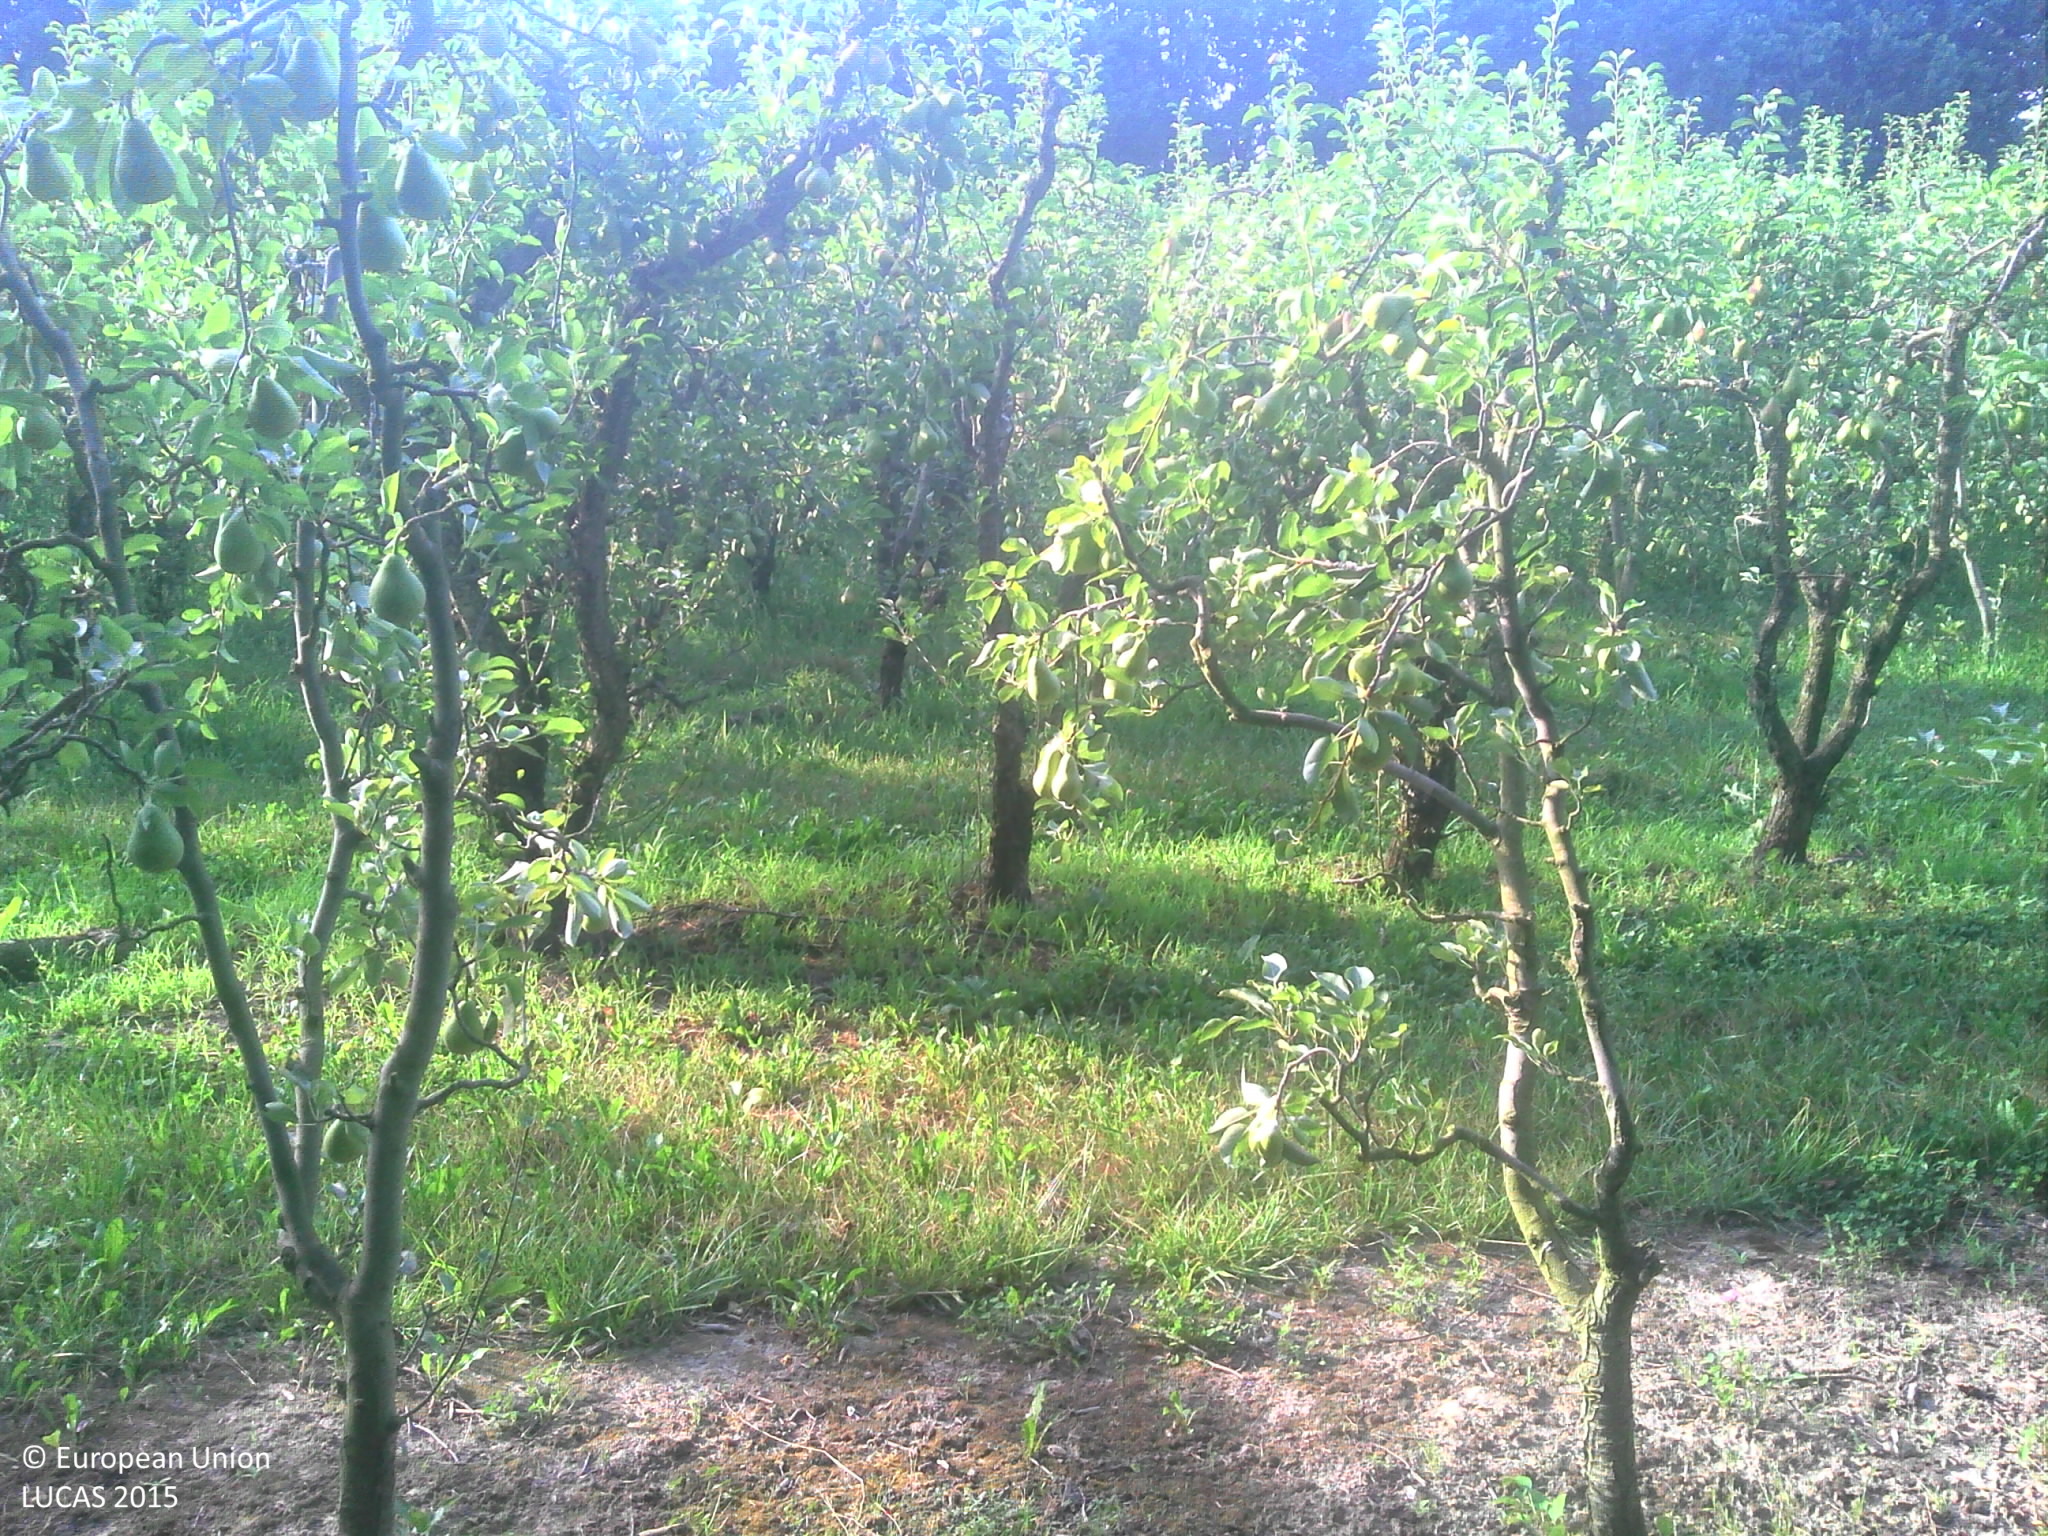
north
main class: Cropland
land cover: Pear fruit
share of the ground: > 75 %
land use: Agriculture (excluding fallow land and kitchen gardens)
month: July
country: FR
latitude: 43.7640
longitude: 5.0777
